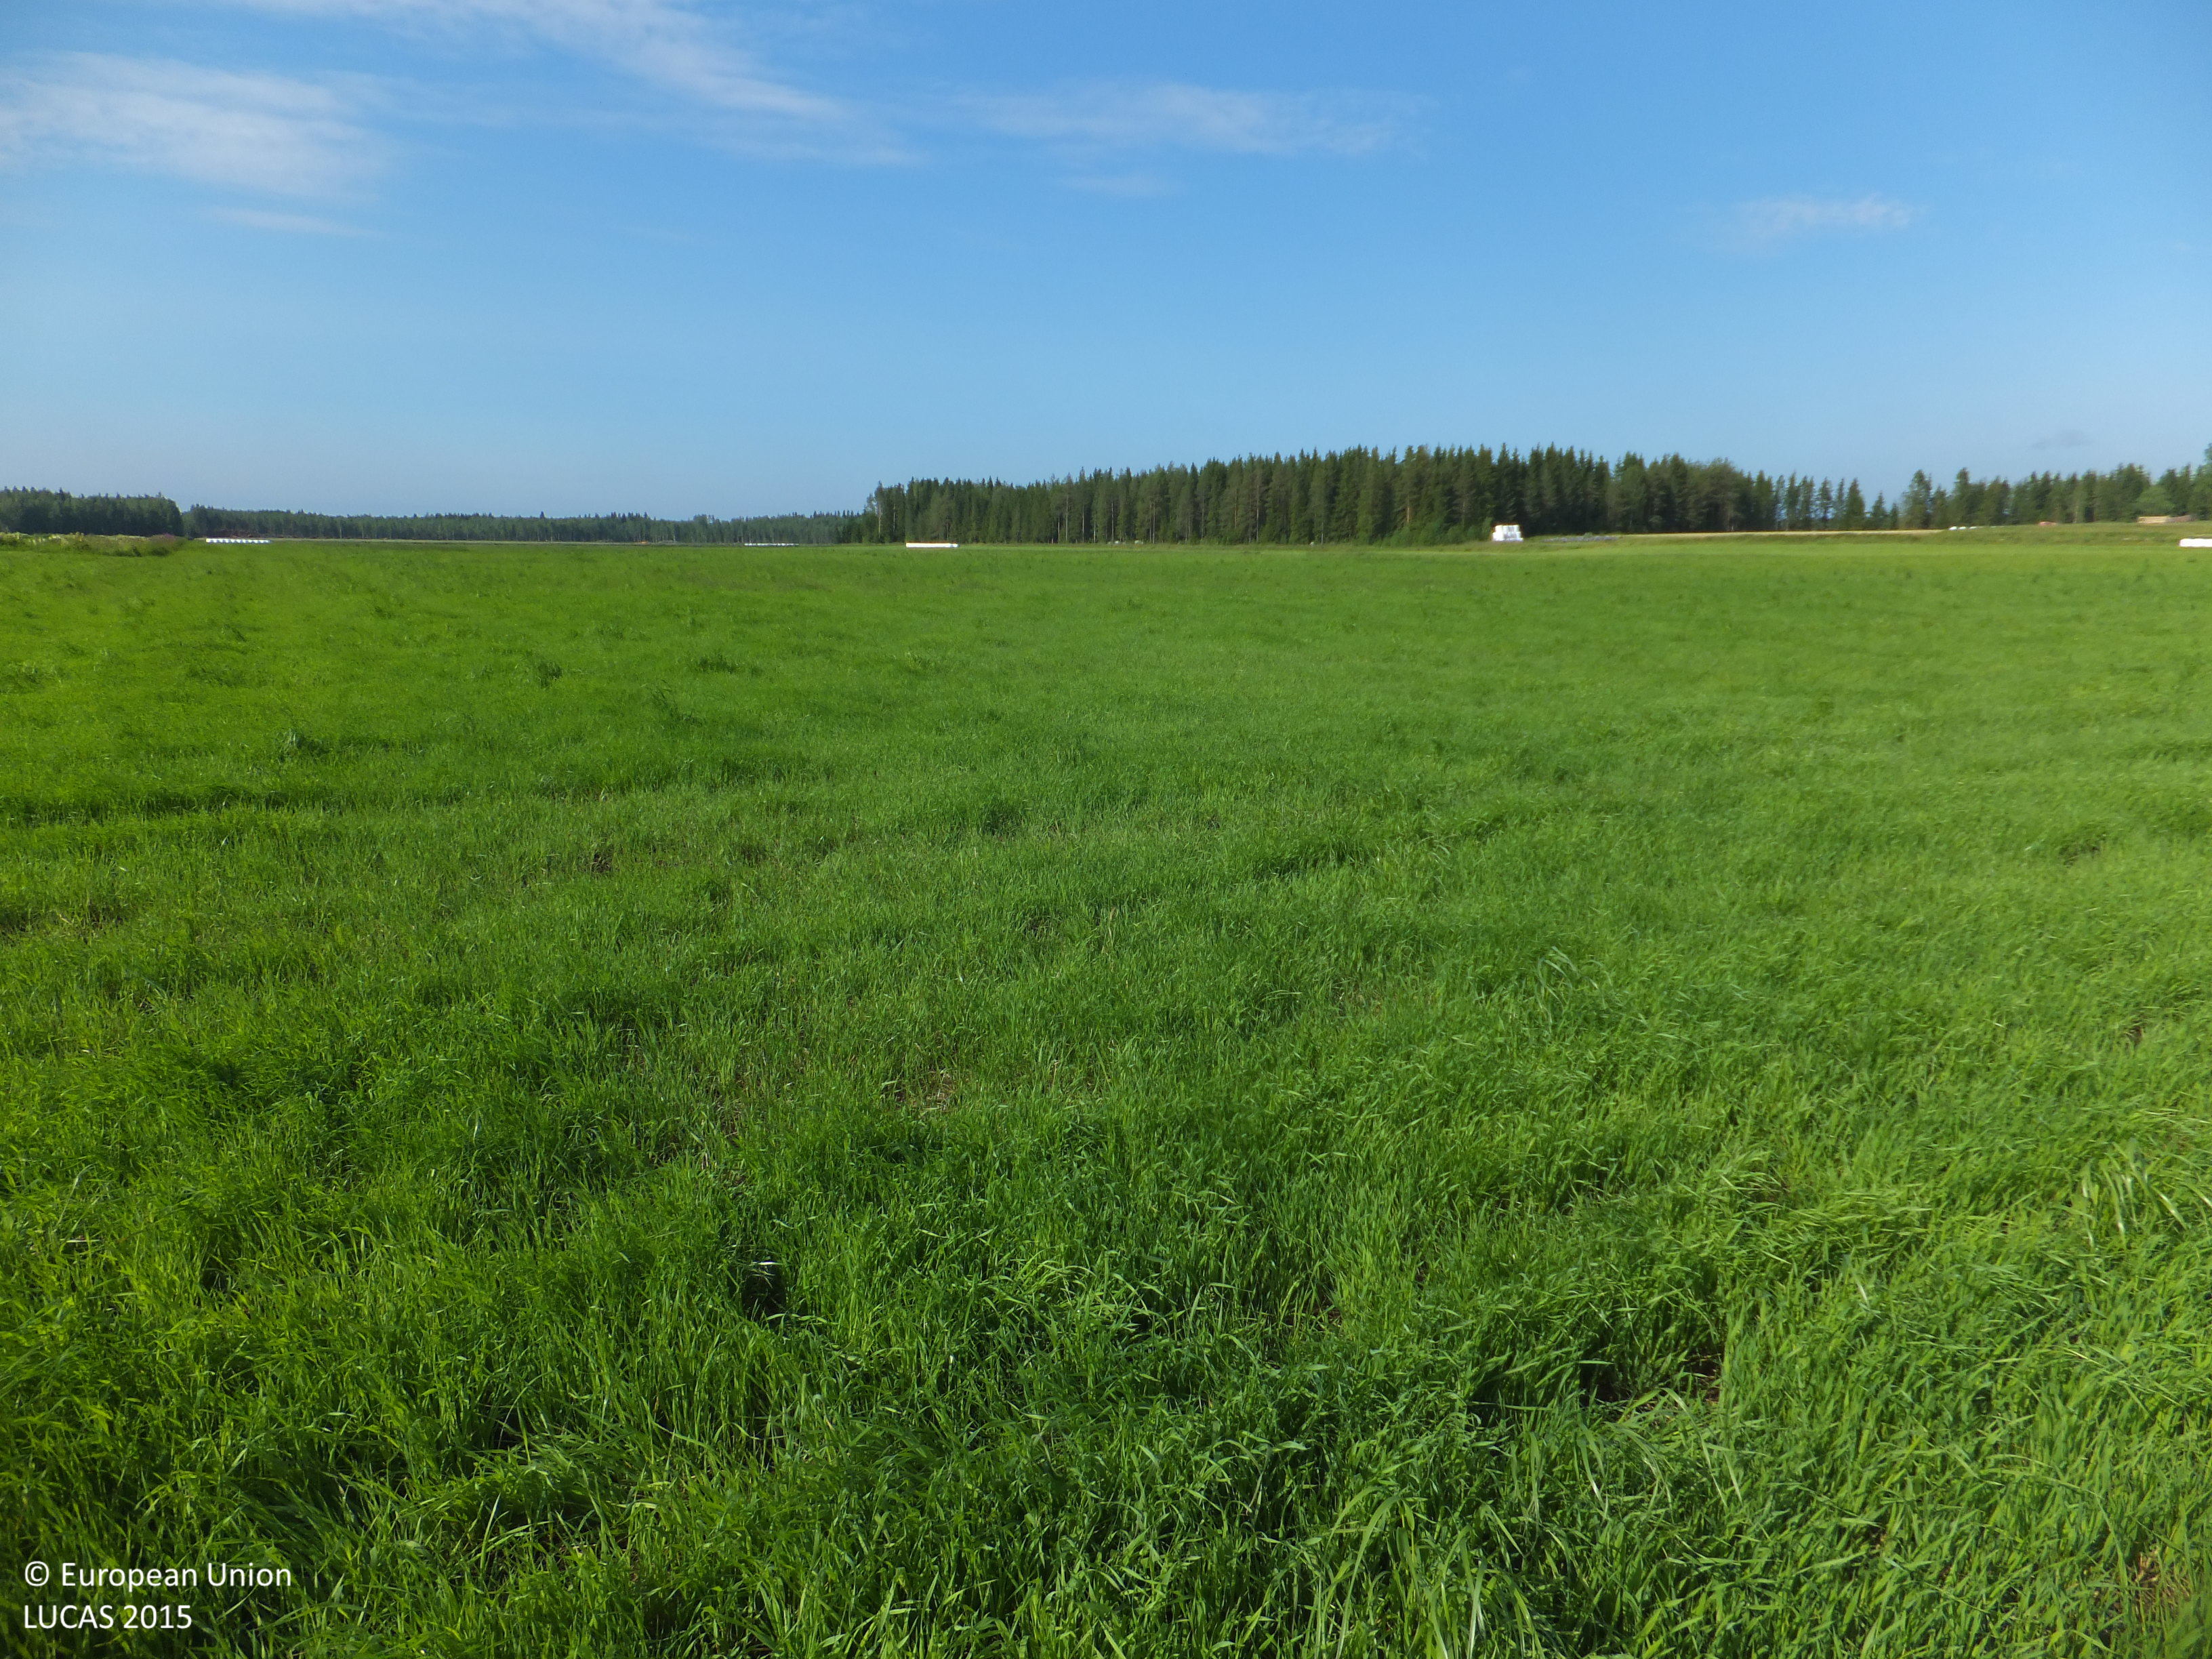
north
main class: Cropland
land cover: Temporary grasslands
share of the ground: > 75 %
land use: Agriculture (excluding fallow land and kitchen gardens)
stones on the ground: < 10 %
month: July
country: FI
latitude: 63.6345
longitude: 23.0719
